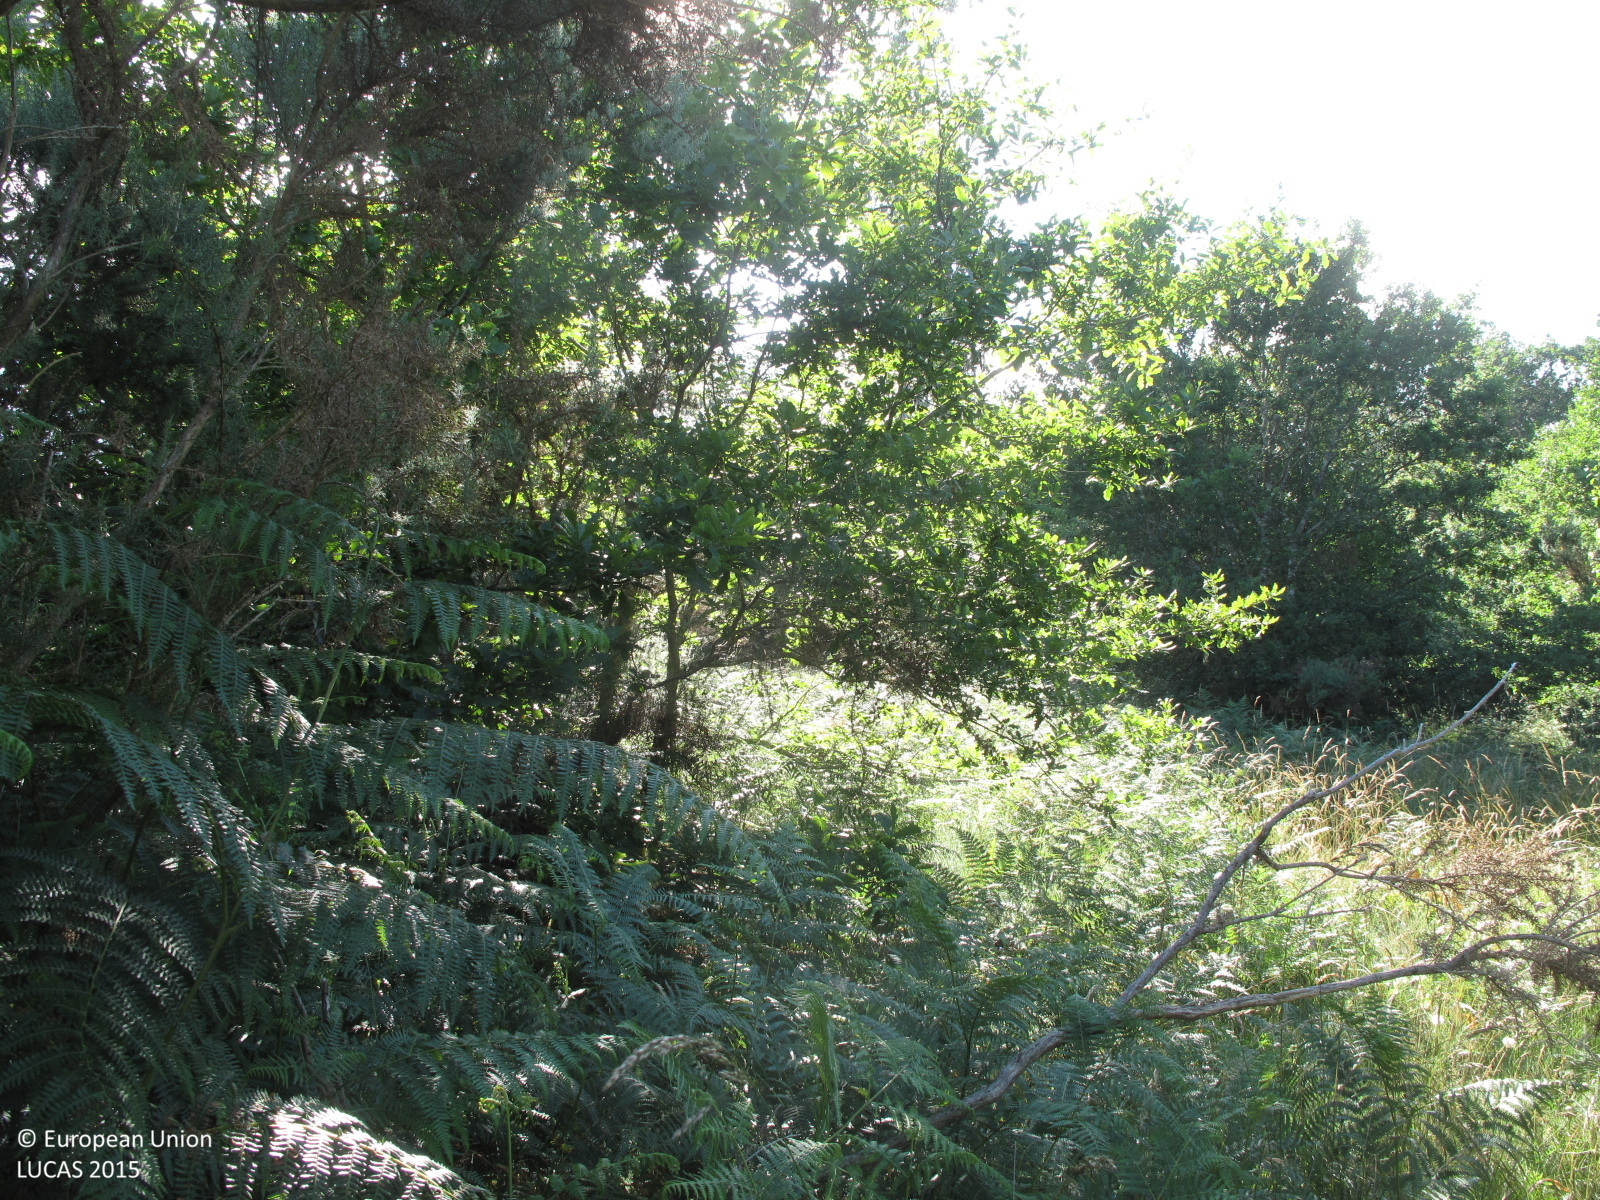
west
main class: Woodland
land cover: Other mixed woodland
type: acidophilous oak and oak-birch forest
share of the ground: 50 - 75 %
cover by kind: shrubs 40 %, broadleaved forest trees 30 %, coniferous forest trees 20 %, herbaceous plants 10 %
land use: Semi-natural and natural areas not in use
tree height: > 5 m
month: June
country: ES
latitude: 42.9286
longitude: -8.4950
